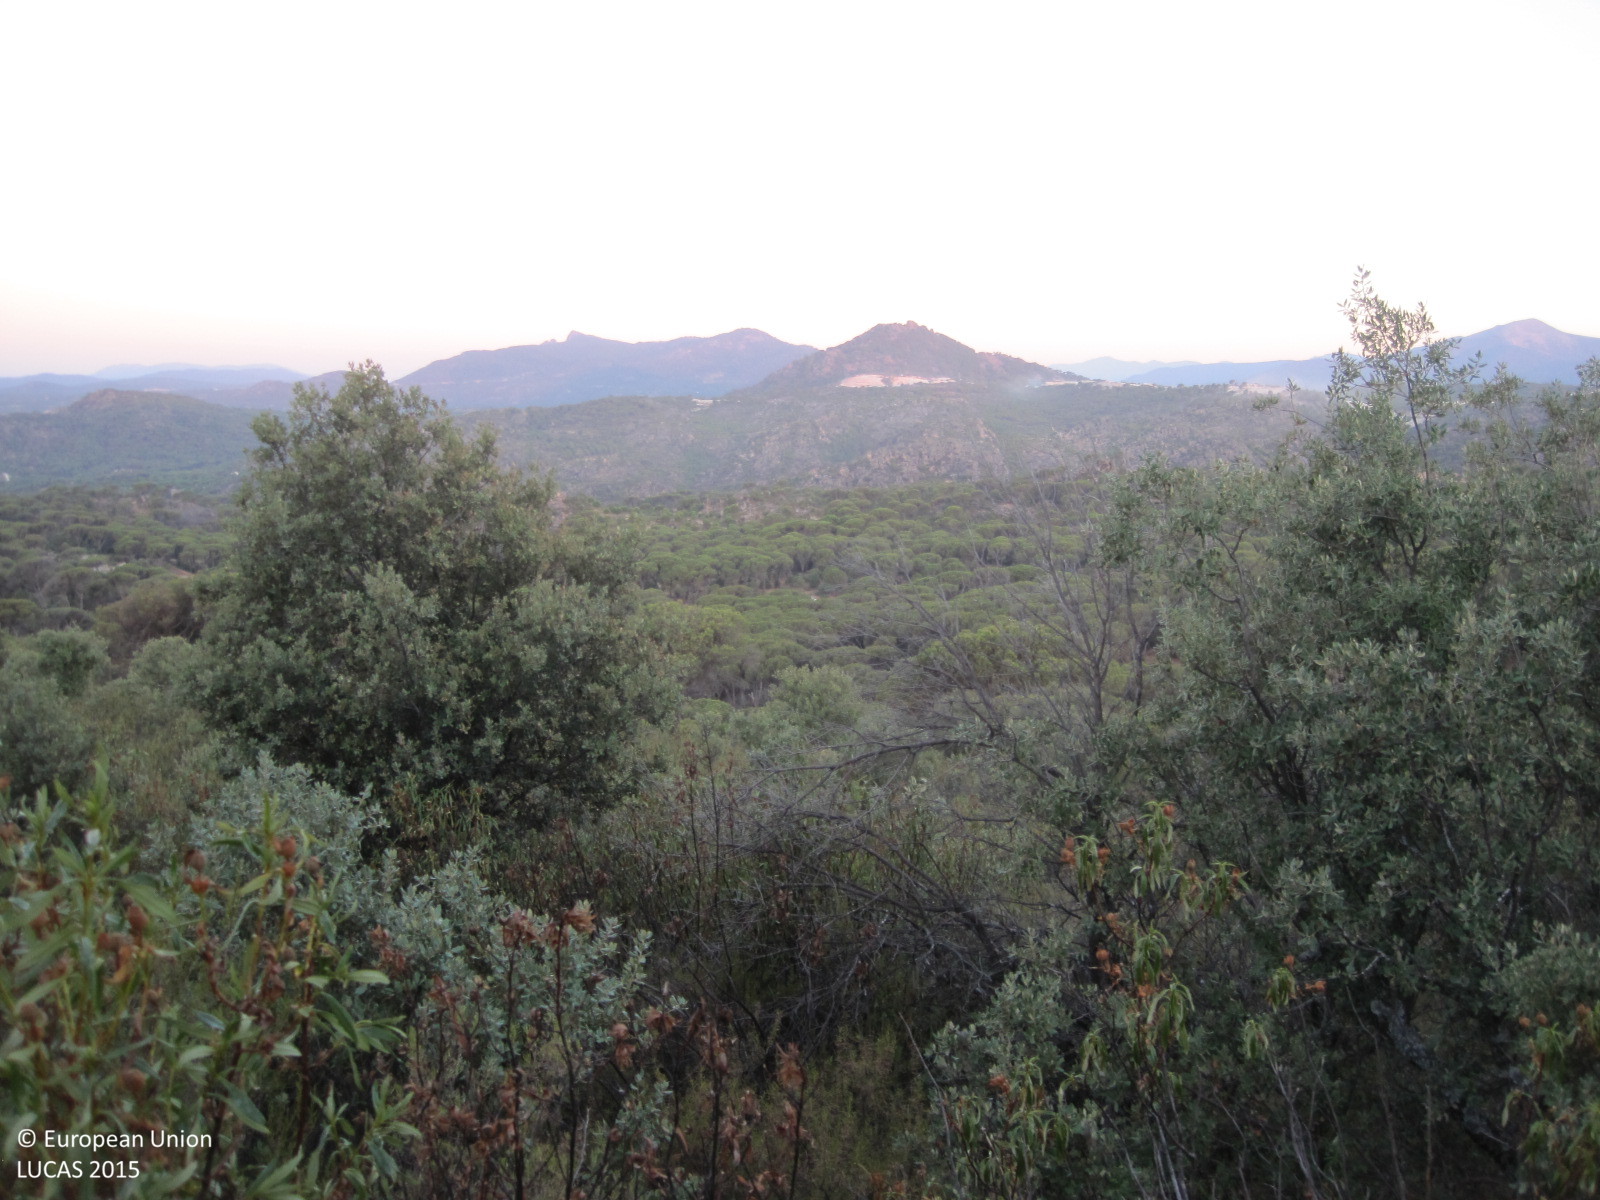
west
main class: Woodland
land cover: Pine dominated mixed woodland
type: coniferous forest of the mediterranean region
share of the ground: > 75 %
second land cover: Shrubland without tree cover
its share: 50 - 75 %
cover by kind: coniferous forest trees 70 %, broadleaved forest trees 30 %
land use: Forestry
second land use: Agriculture (excluding fallow land and kitchen gardens)
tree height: > 5 m
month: July
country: ES
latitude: 40.3047
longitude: -4.3643
